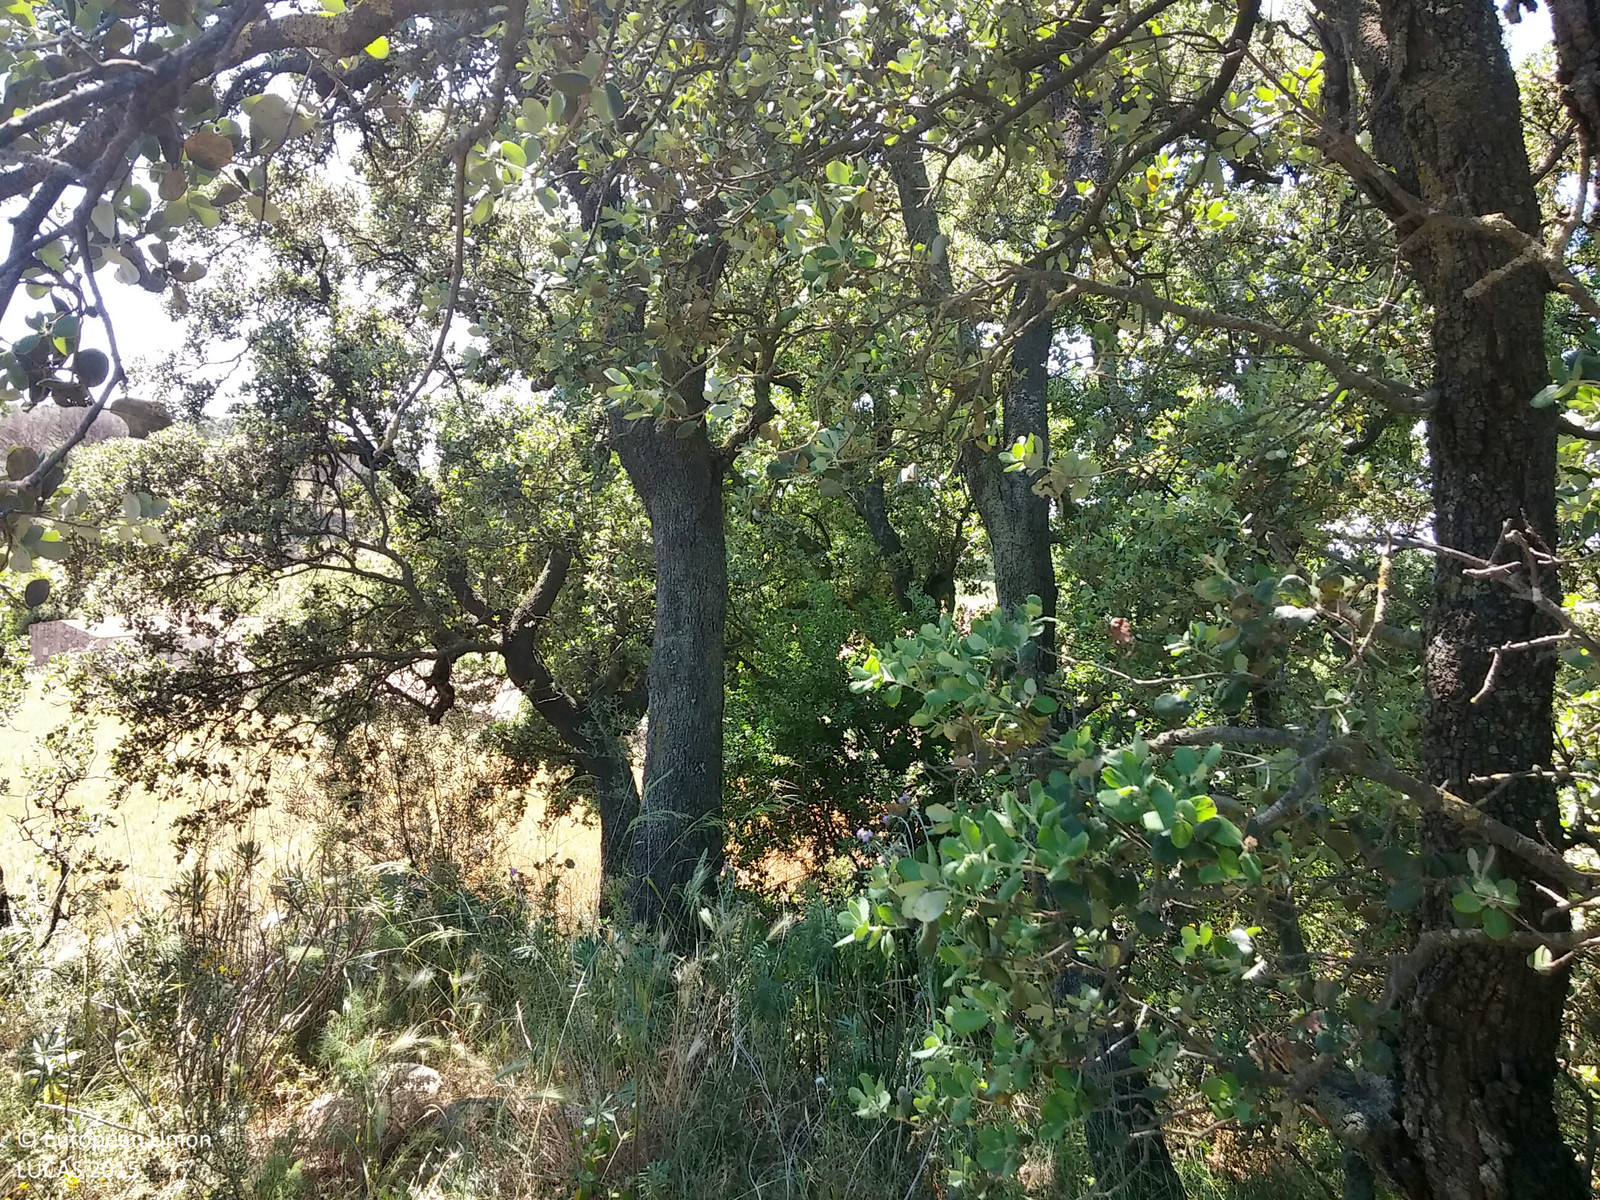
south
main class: Woodland
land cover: Broadleaved woodland
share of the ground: 25 - 50 %
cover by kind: herbaceous plants 55 %, broadleaved forest trees 35 %, shrubs 10 %
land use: Forestry
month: May
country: ES
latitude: 42.3545
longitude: 2.9602
